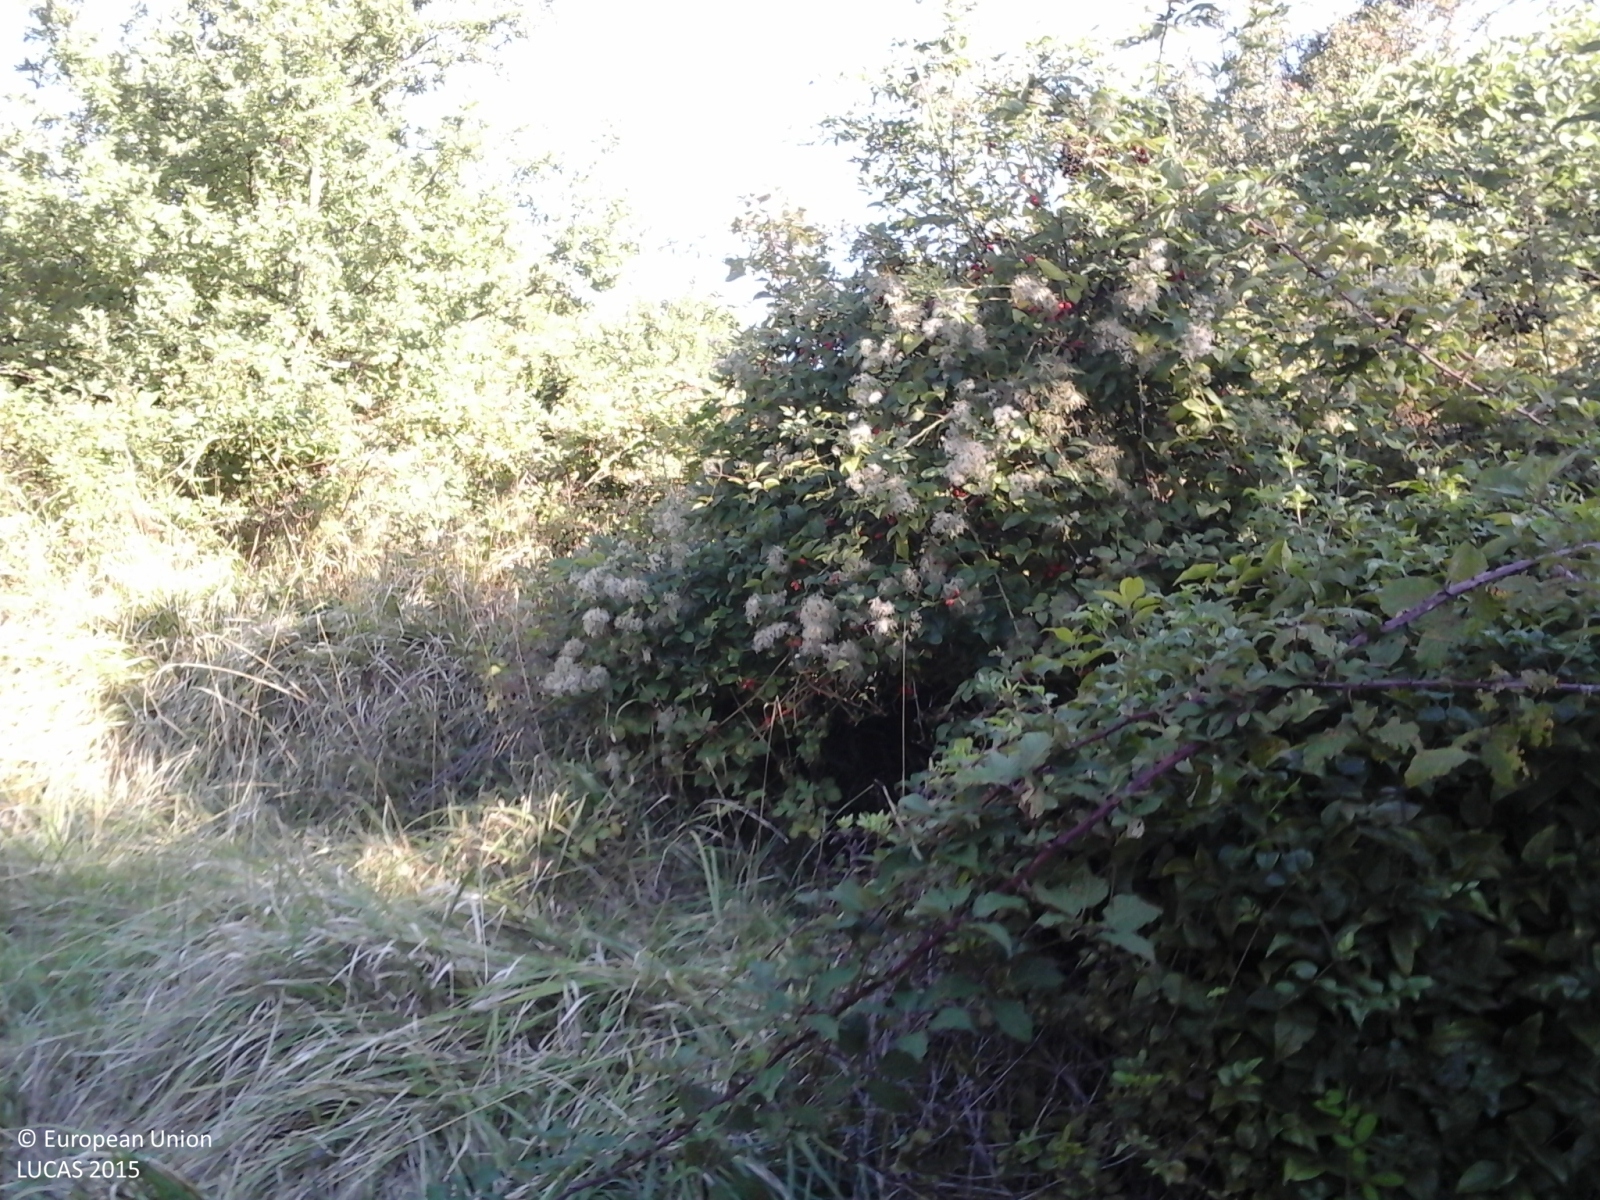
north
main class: Grassland
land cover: Grassland with sparse tree/shrub cover
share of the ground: > 75 %
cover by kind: herbaceous plants 80 %, shrubs 10 %, broadleaved forest trees 5 %, lichens and mosses 5 %
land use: Agriculture (excluding fallow land and kitchen gardens)
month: September
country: IT
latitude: 44.3936
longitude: 8.4843
